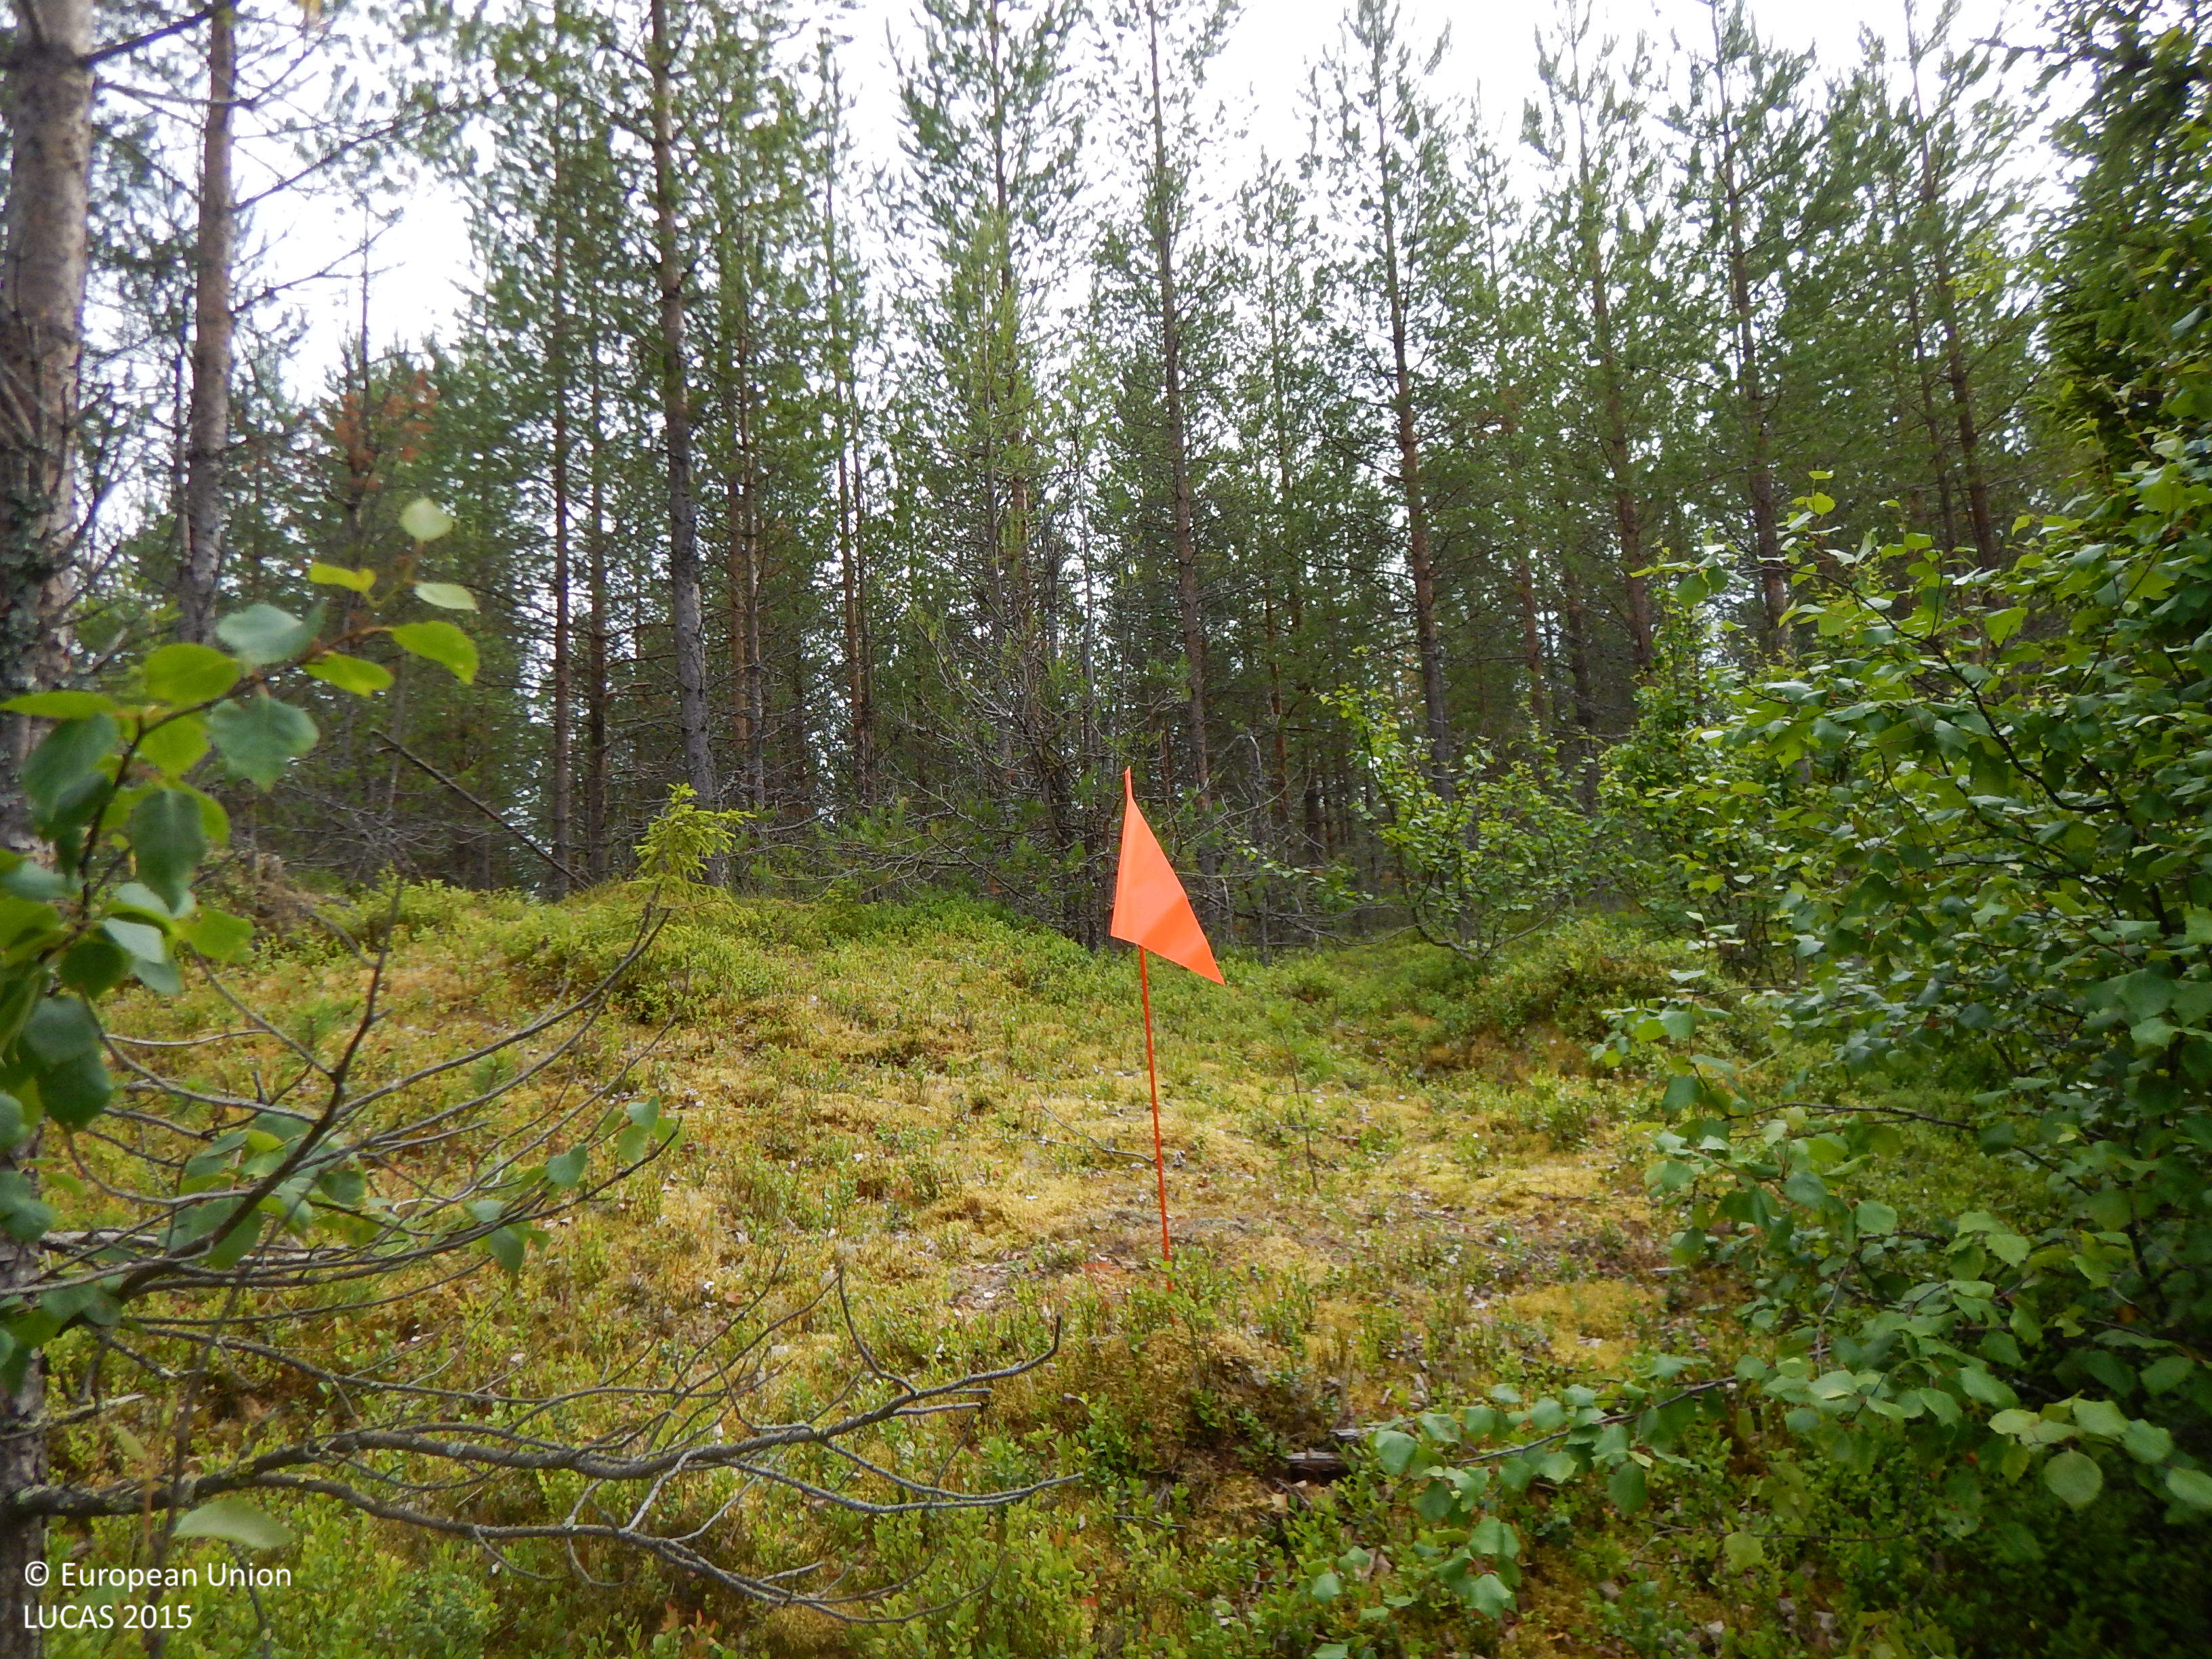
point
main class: Woodland
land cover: Pine dominated mixed woodland
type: boreal forest
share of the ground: 50 - 75 %
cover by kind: coniferous forest trees 35 %, shrubs 20 %, broadleaved forest trees 15 %, herbaceous plants 15 %, lichens and mosses 15 %
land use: Forestry
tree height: < 5 m
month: July
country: SE
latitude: 64.6645
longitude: 20.2999
